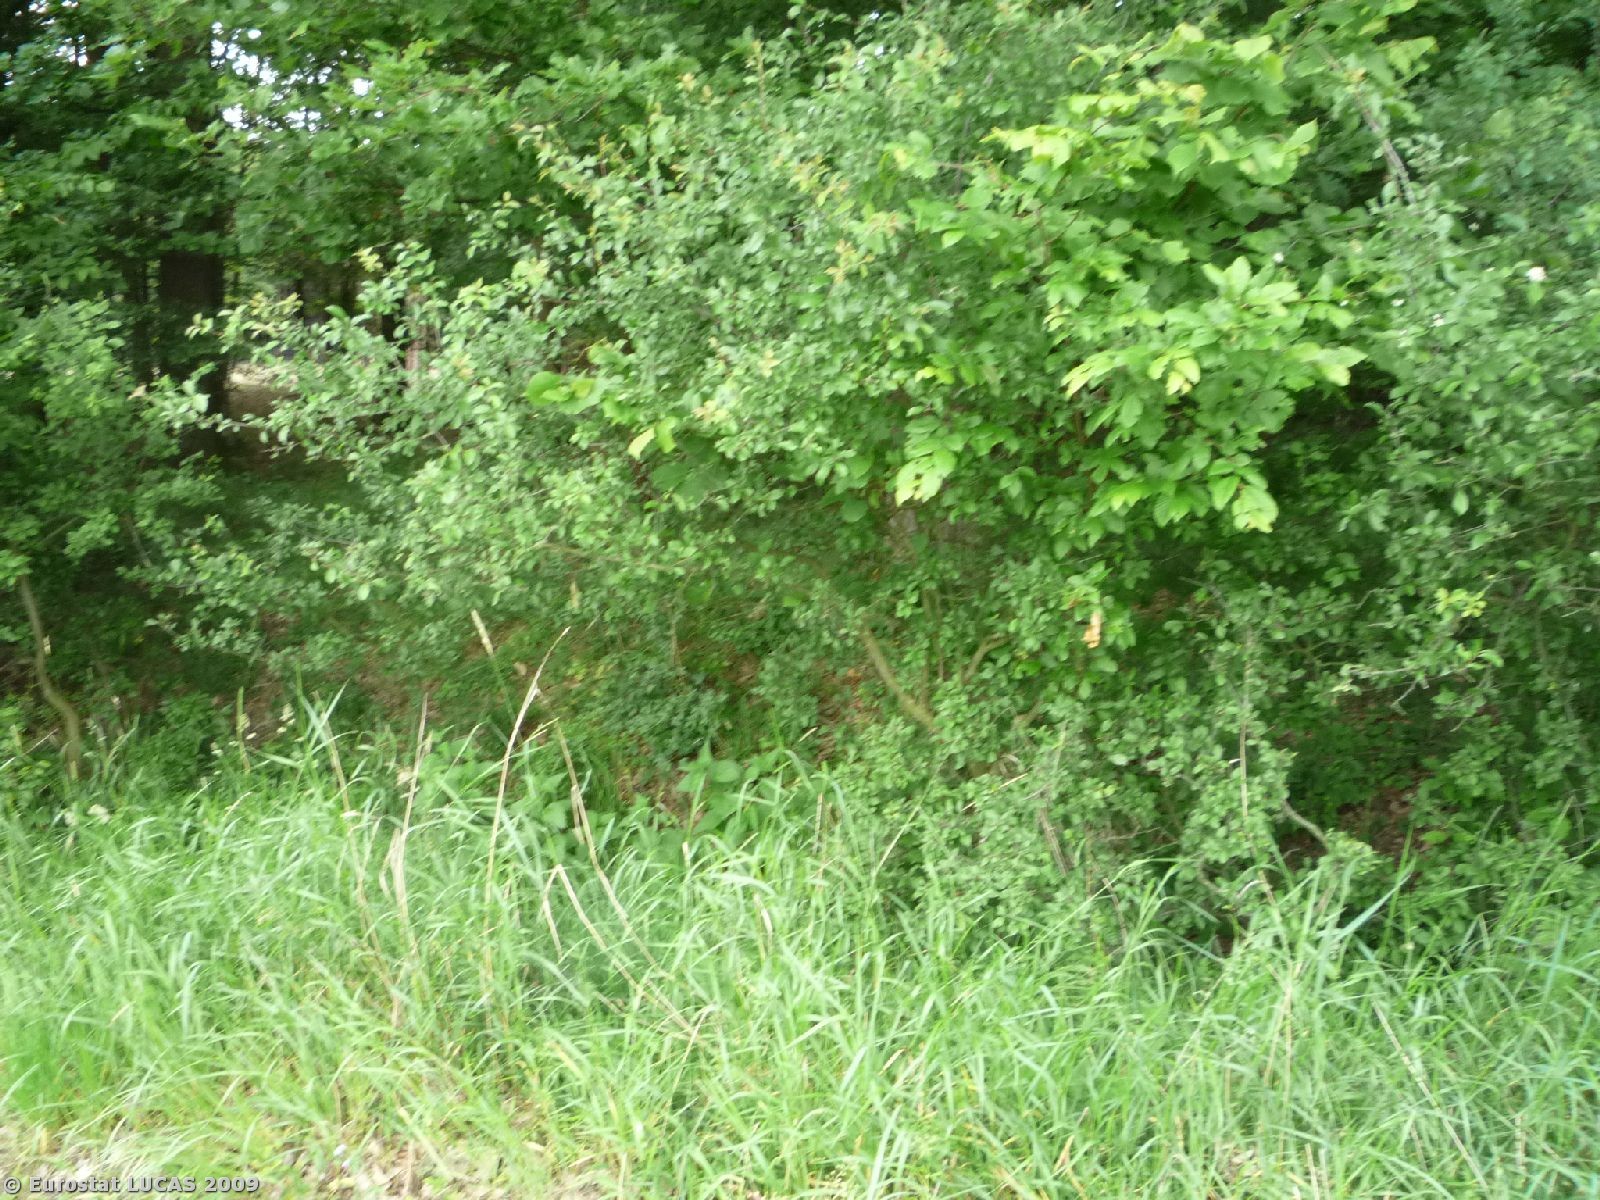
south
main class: Cropland
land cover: Clovers
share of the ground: > 75 %
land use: Agriculture (excluding fallow land and kitchen gardens)
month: May
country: CZ
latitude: 50.3028
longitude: 15.5218
